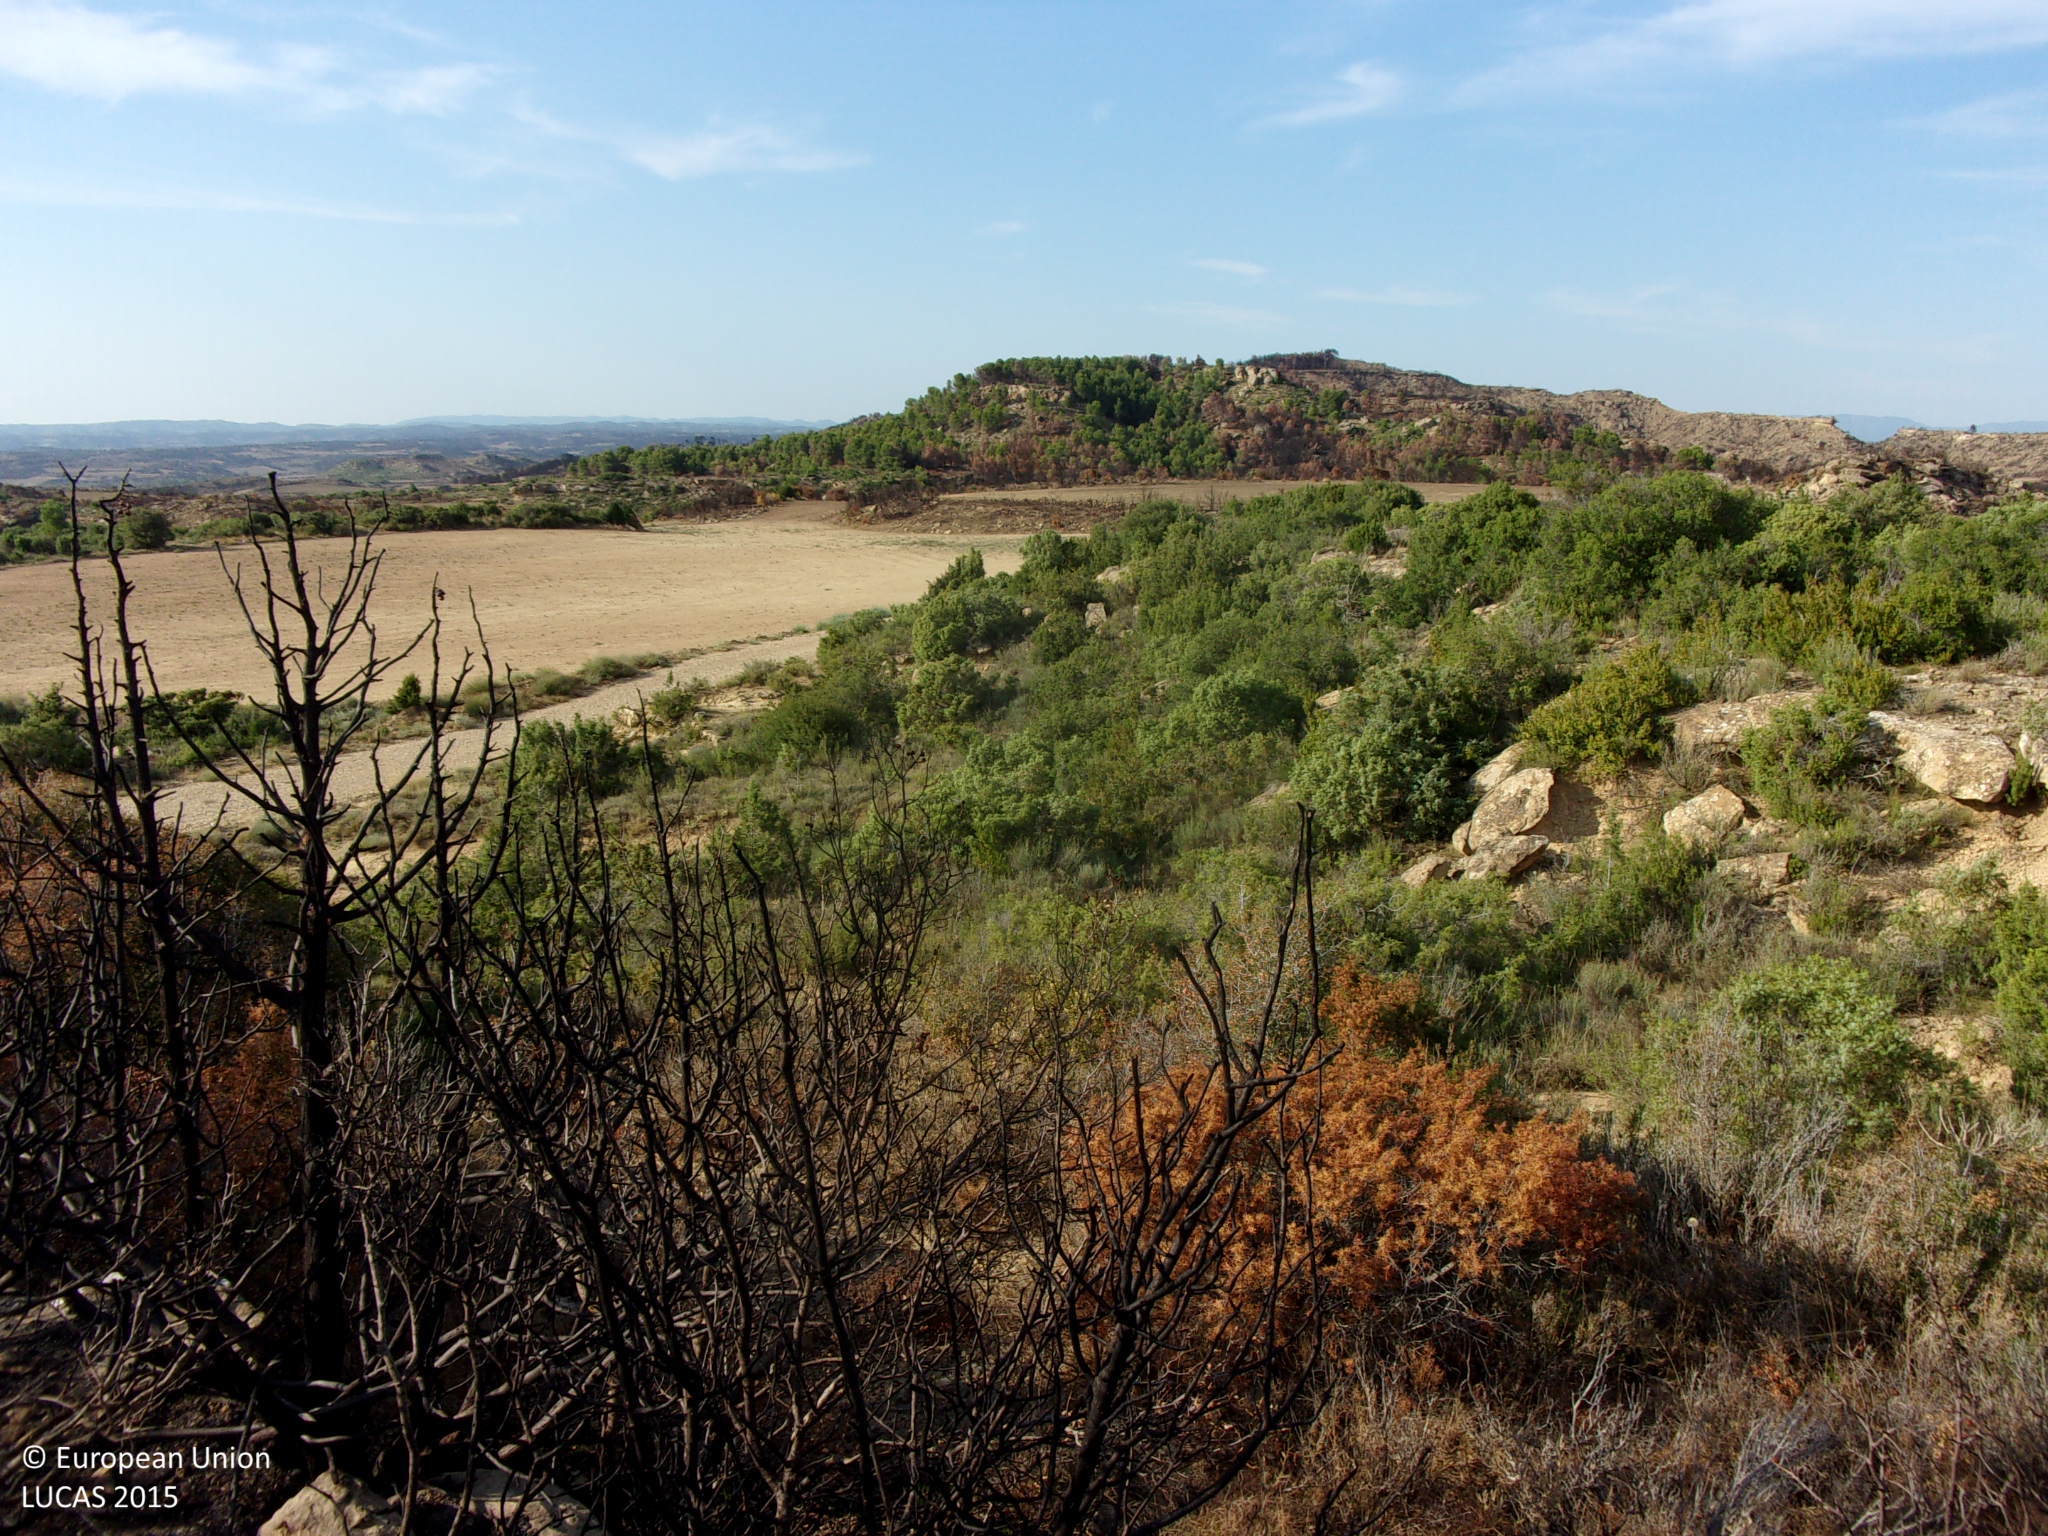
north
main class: Shrubland
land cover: Shrubland without tree cover
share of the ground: 10 - 25 %
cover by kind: unconsolidated bare surface 90 %, shrubs 10 %
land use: Semi-natural and natural areas not in use
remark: Burnt area
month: August
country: ES
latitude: 42.2100
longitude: -1.0629
